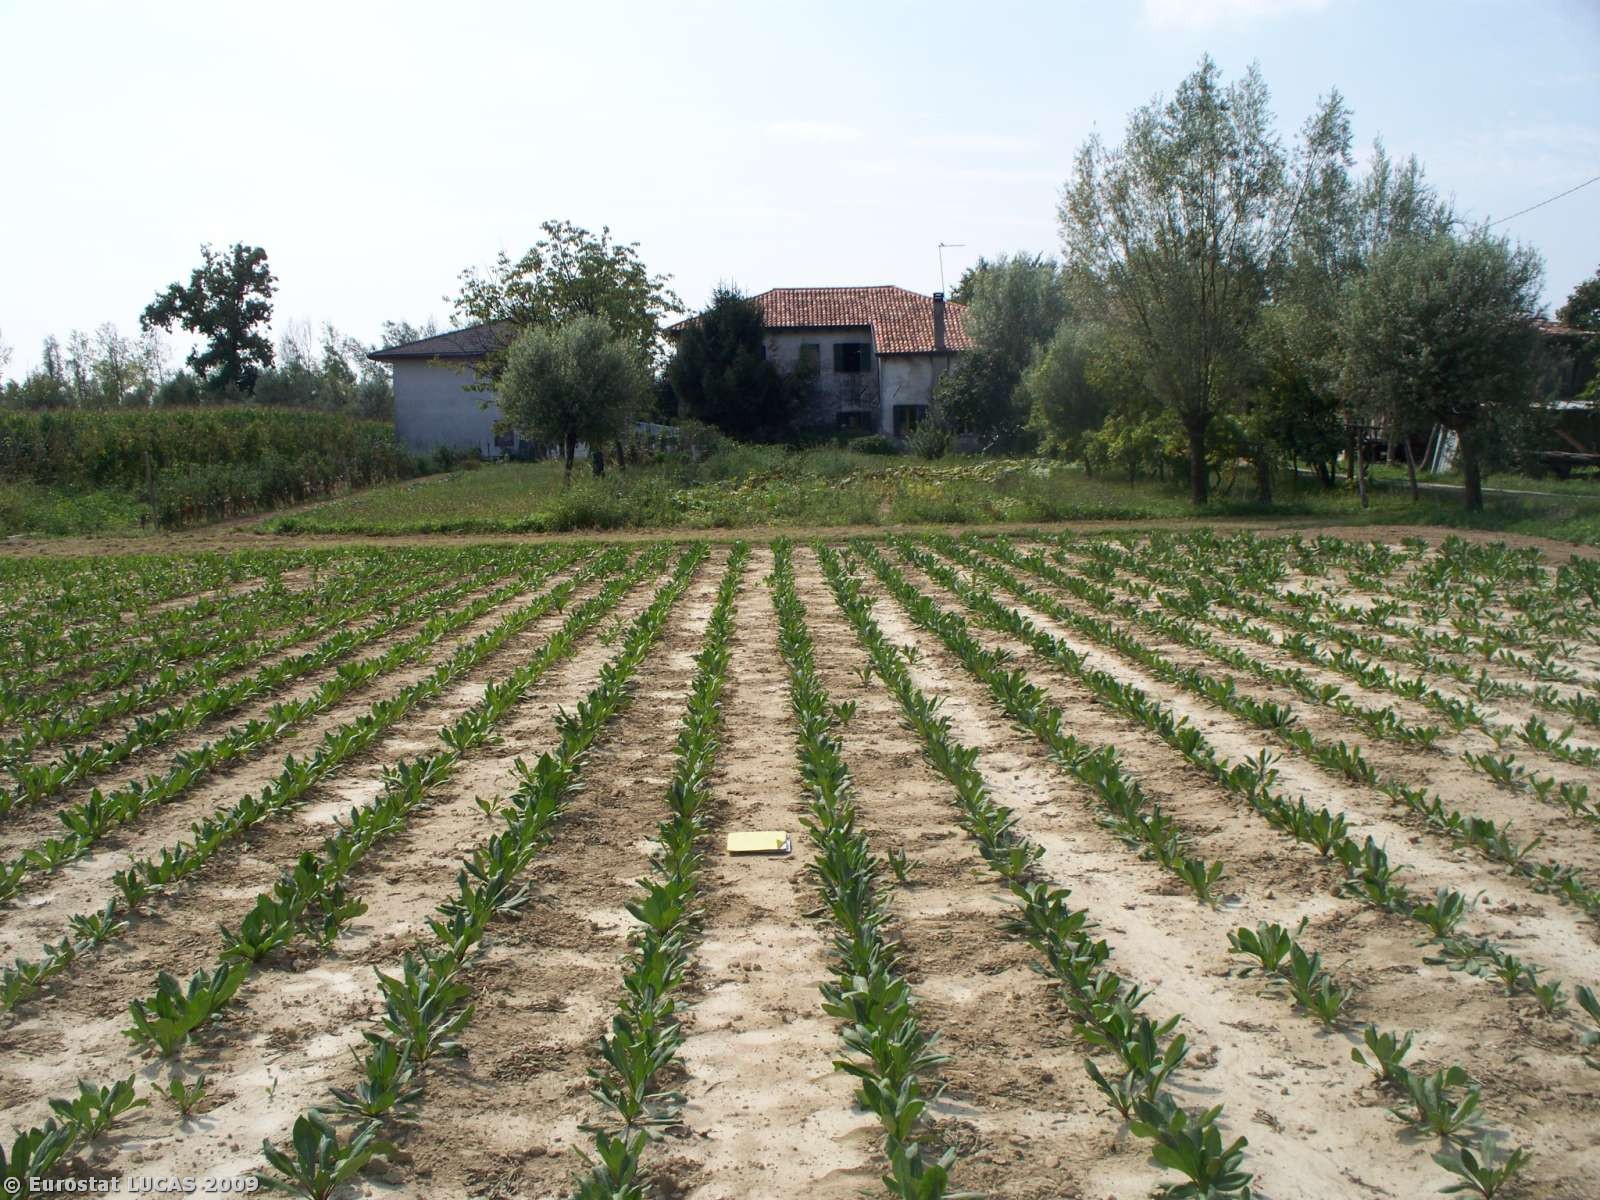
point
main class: Cropland
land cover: Other fresh vegetables
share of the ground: < 10 %
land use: Kitchen garden
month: May
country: IT
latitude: 45.5559
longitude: 12.0848
